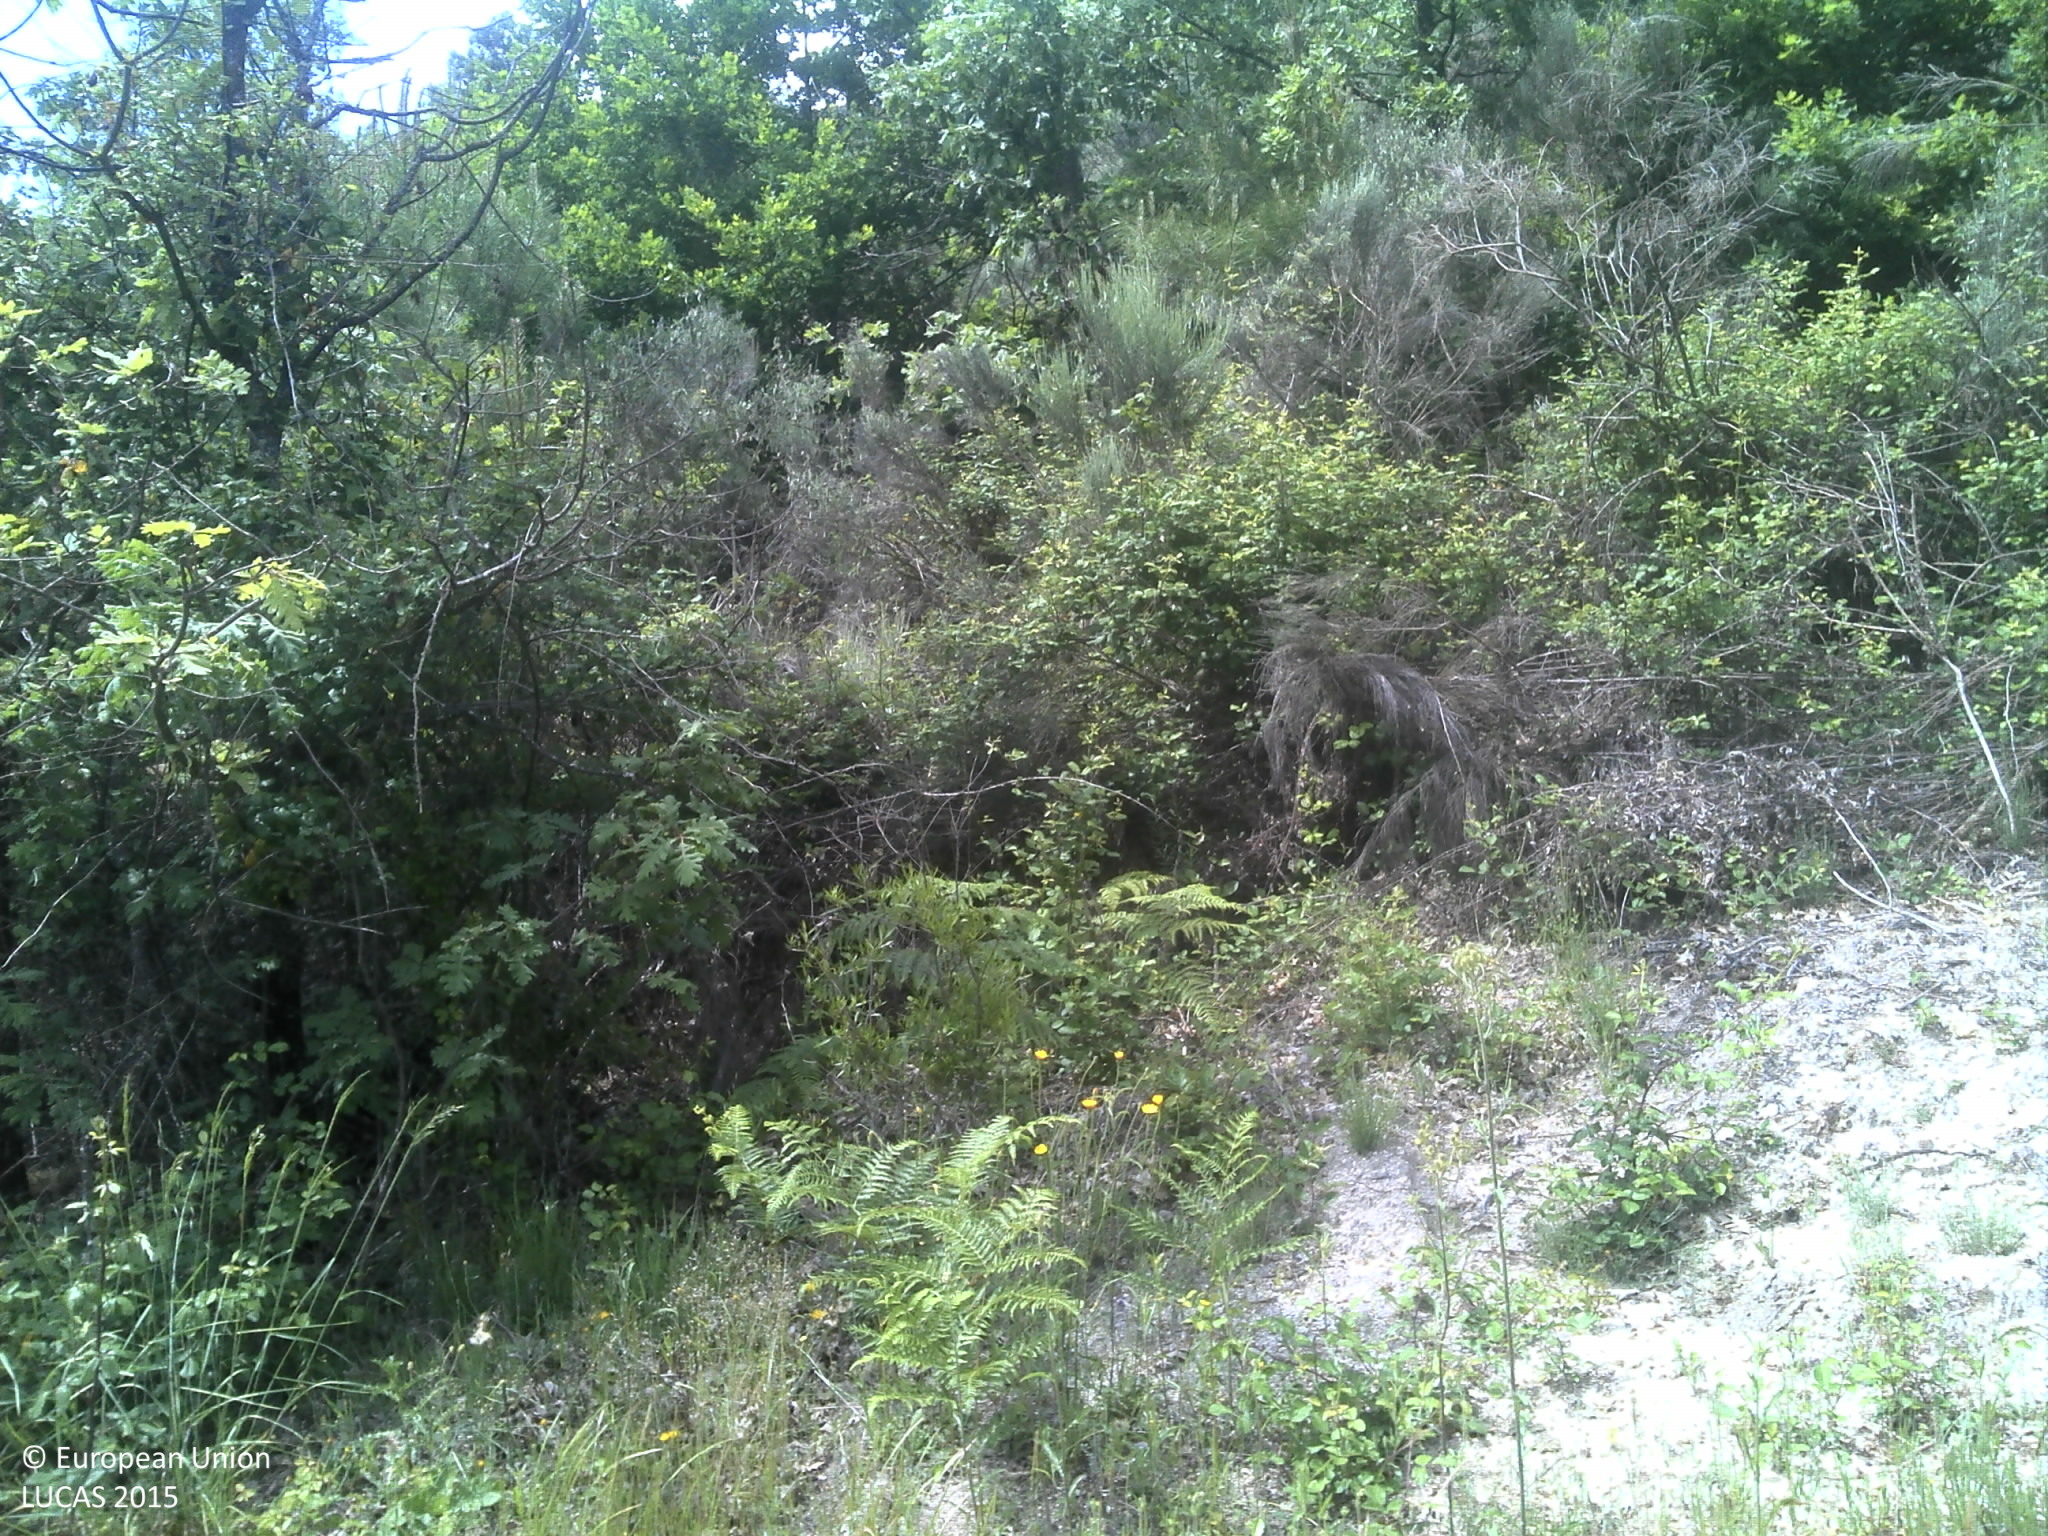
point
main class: Shrubland
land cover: Shrubland with sparse tree cover
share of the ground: 50 - 75 %
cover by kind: shrubs 70 %, unconsolidated bare surface 10 %, broadleaved forest trees 5 %, herbaceous plants 5 %
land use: Semi-natural and natural areas not in use
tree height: > 5 m
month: May
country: PT
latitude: 40.7226
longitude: -7.4335
